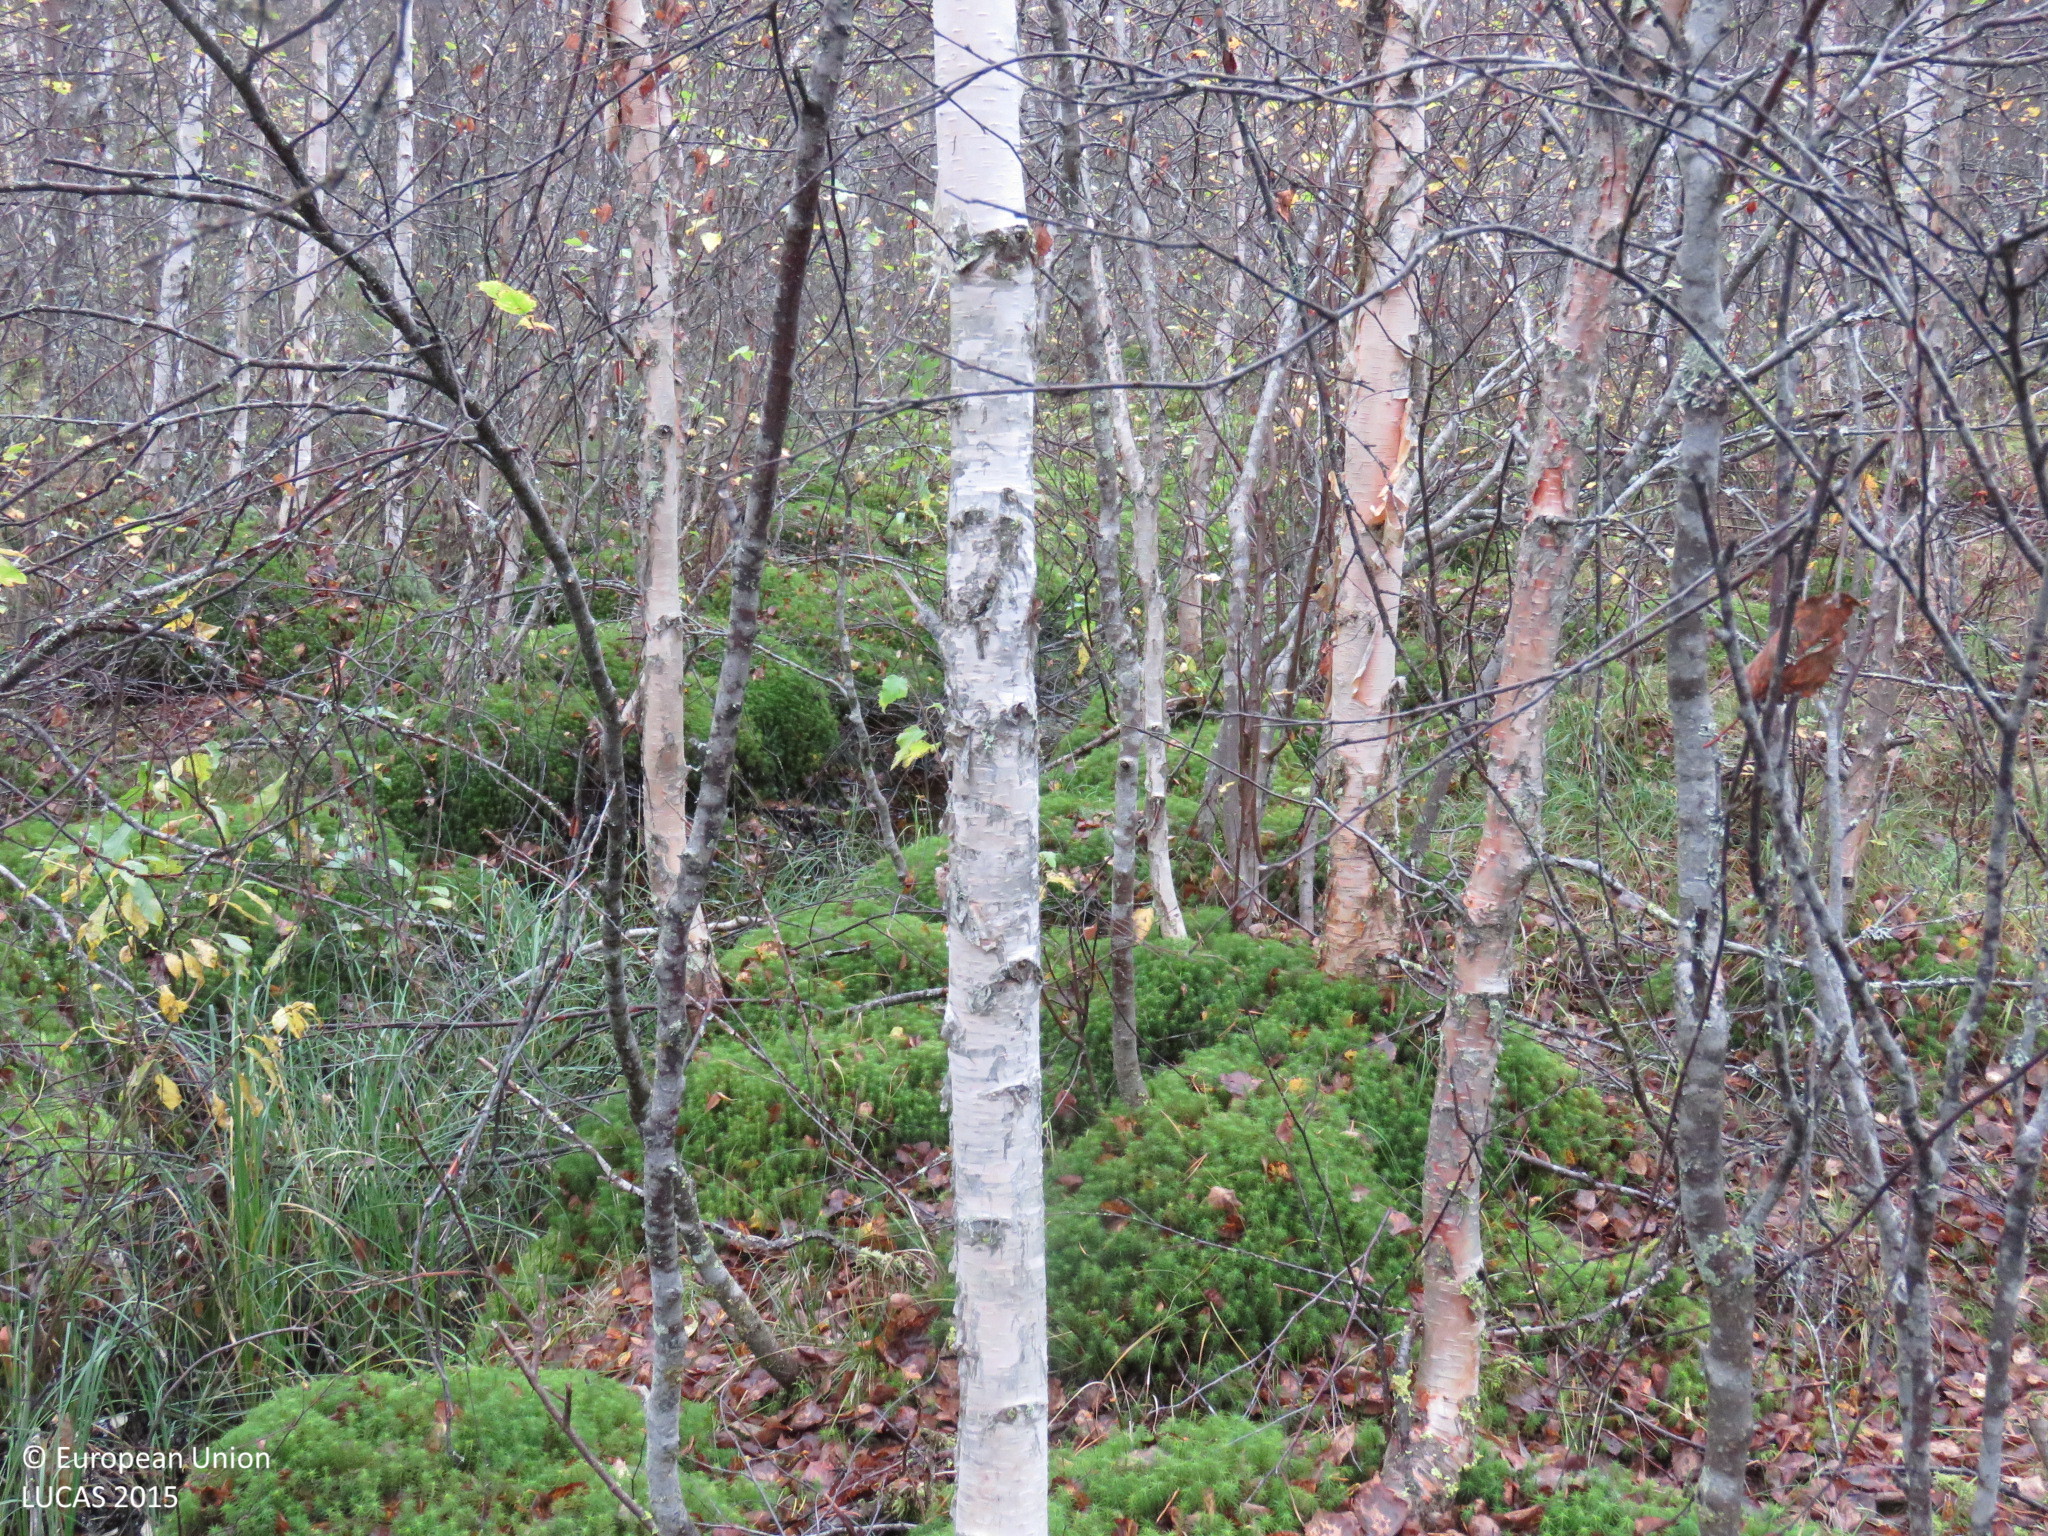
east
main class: Woodland
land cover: Broadleaved woodland
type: mire and swamp forests
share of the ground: > 75 %
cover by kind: broadleaved forest trees 70 %, coniferous forest trees 10 %, herbaceous plants 10 %, lichens and mosses 10 %
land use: Forestry
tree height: > 5 m
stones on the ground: < 10 %
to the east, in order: Broadleaved woodland; Ditches and canals; Broadleaved woodland; Ditches and canals; Broadleaved woodland; Ditches and canals; Broadleaved woodland; Pine dominated mixed woodland; Electric lines; Shrubland with sparse tree cover; Ditches and canals; Pine dominated mixed woodland; Ditches and canals; Pine dominated mixed woodland
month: September
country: FI
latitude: 65.1924
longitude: 26.8837
